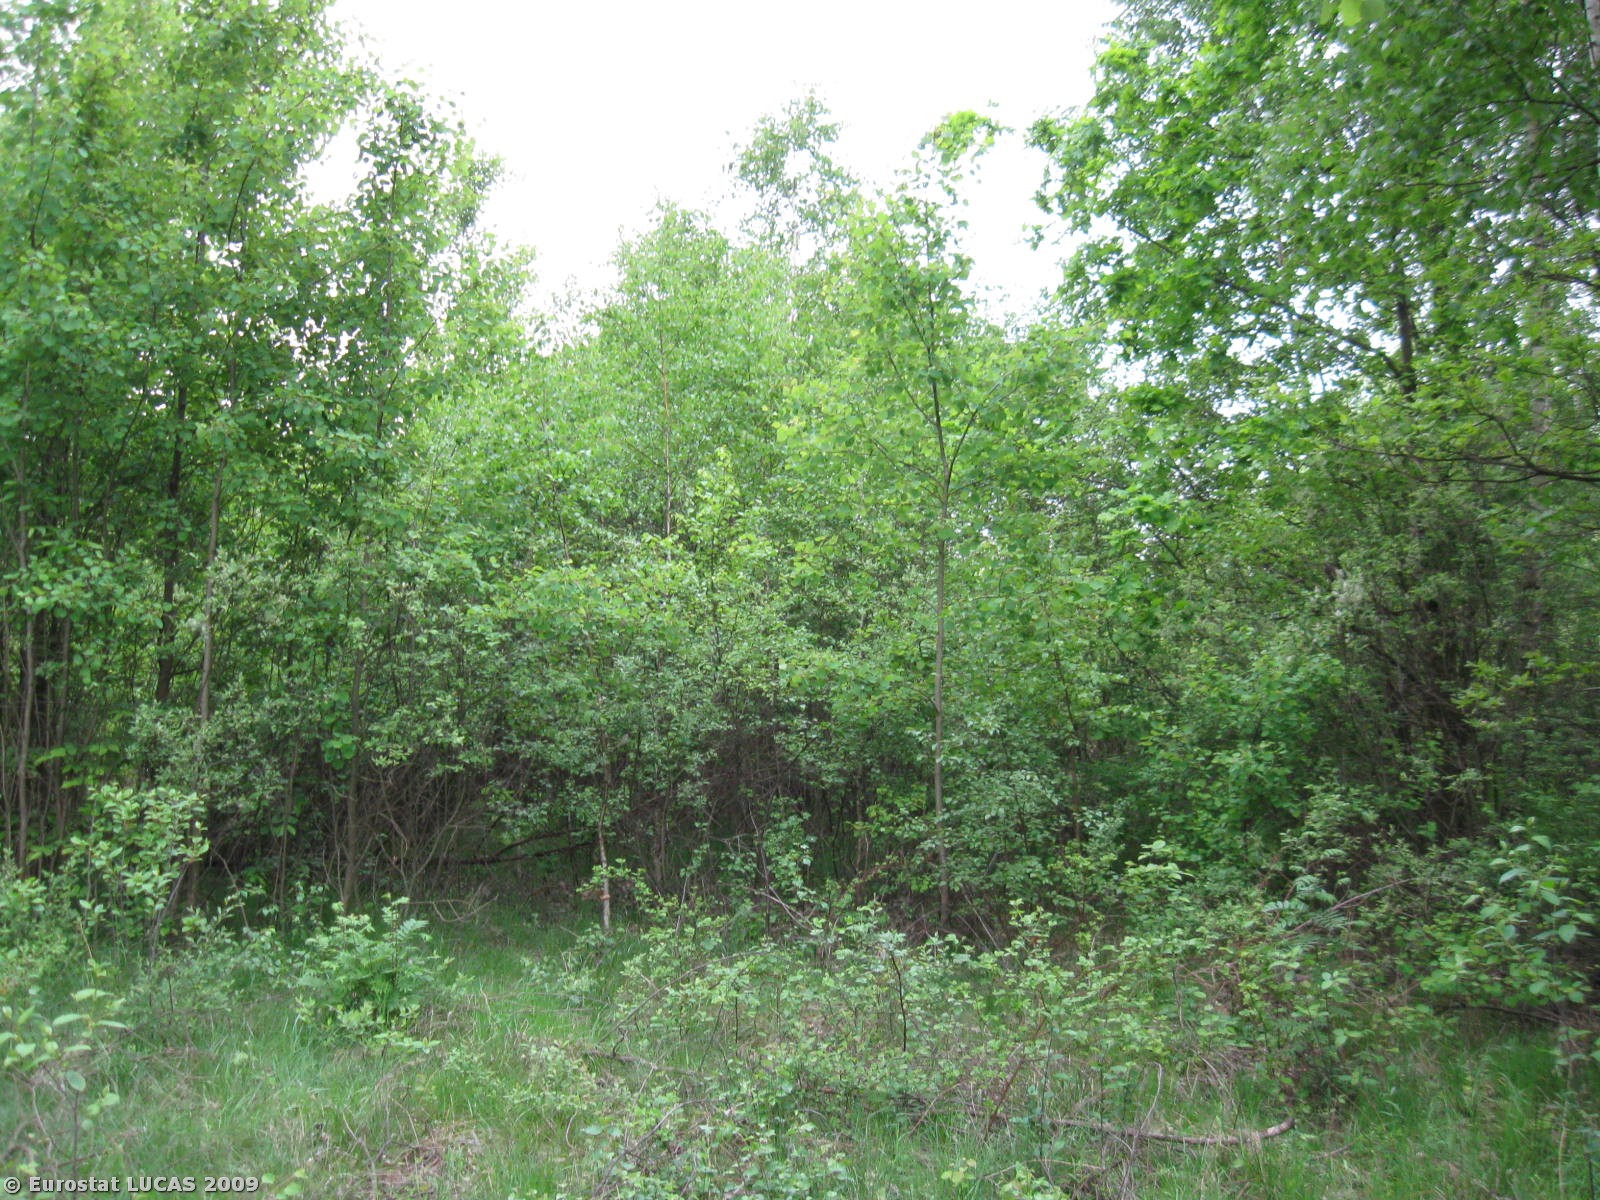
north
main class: Woodland
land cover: Broadleaved woodland
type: hemiboreal forest and nemoral coniferous forest and mixed broadleaved-coniferous forest
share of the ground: > 75 %
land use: Forestry
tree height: > 5 m
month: May
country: PL
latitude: 51.0052
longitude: 20.4843
